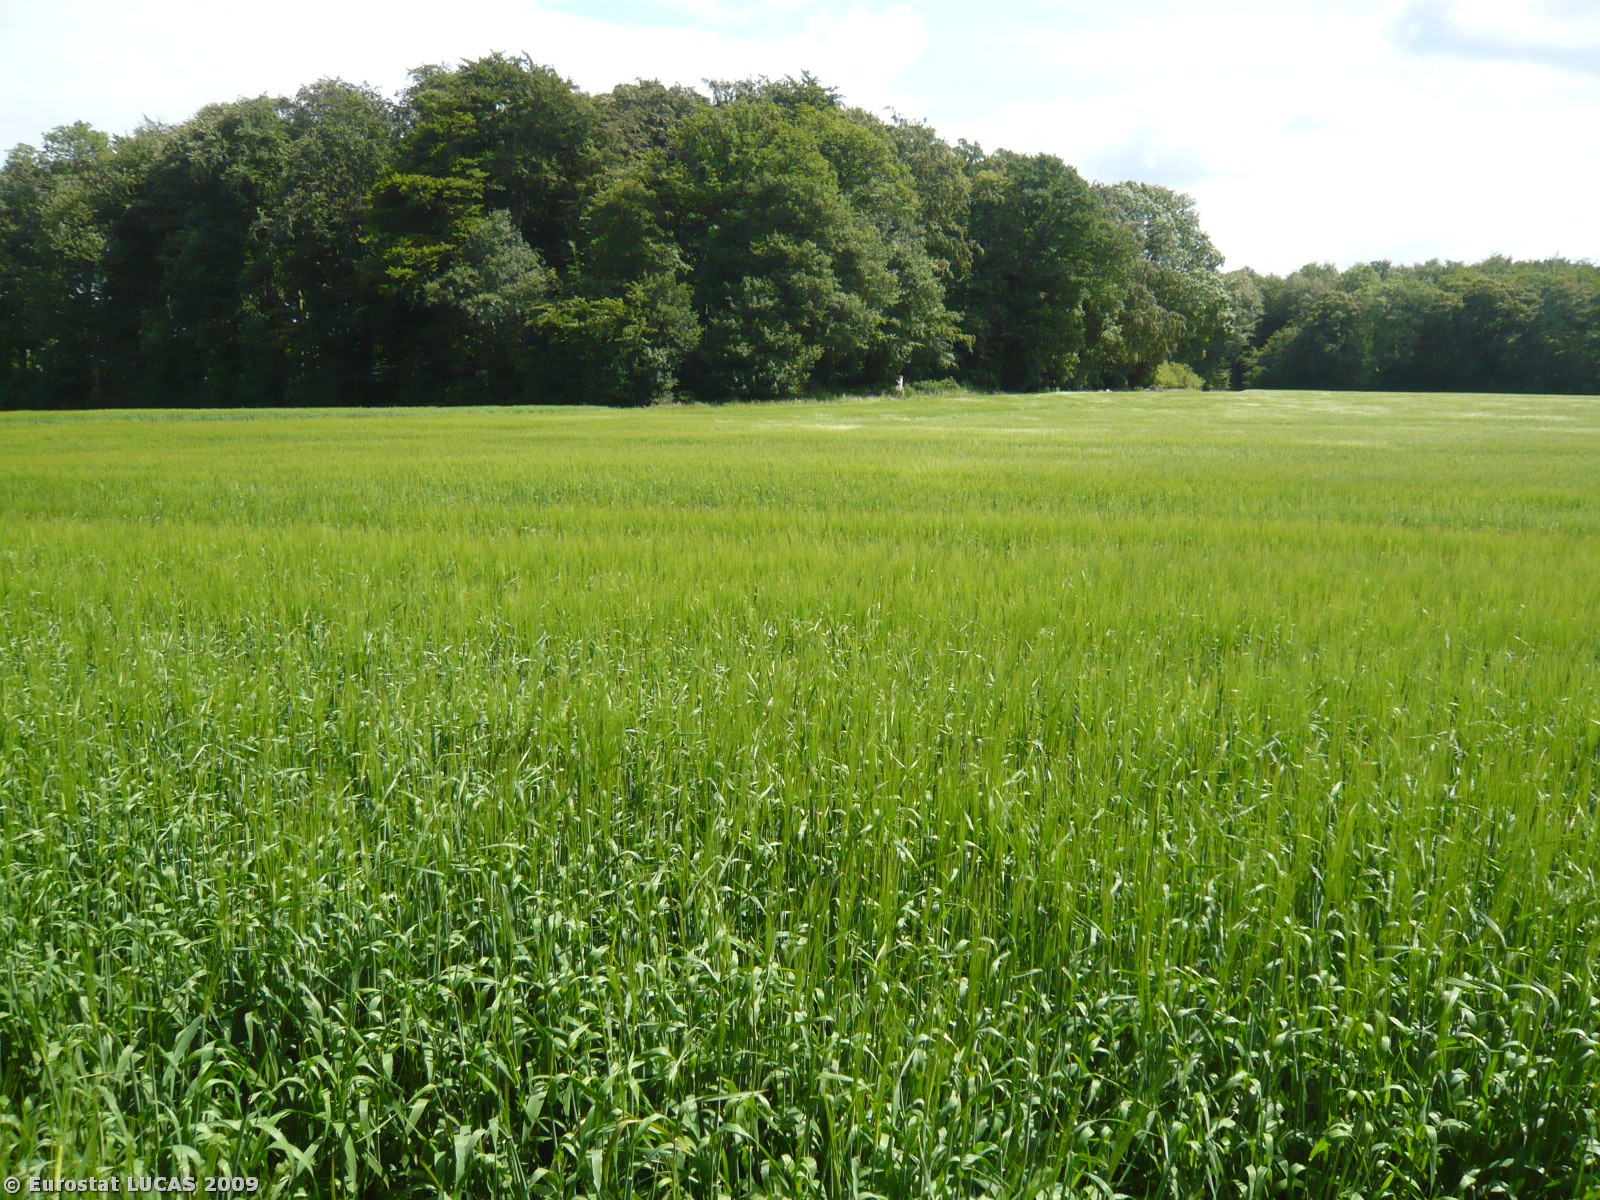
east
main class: Cropland
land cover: Barley
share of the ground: > 75 %
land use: Agriculture (excluding fallow land and kitchen gardens)
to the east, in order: Barley; Grass margins; Tracks; Grass margins; Barley; Broadleaved woodland; Tracks; Broadleaved woodland; Tracks; Broadleaved woodland
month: June
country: DK
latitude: 54.9408
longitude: 11.2947
